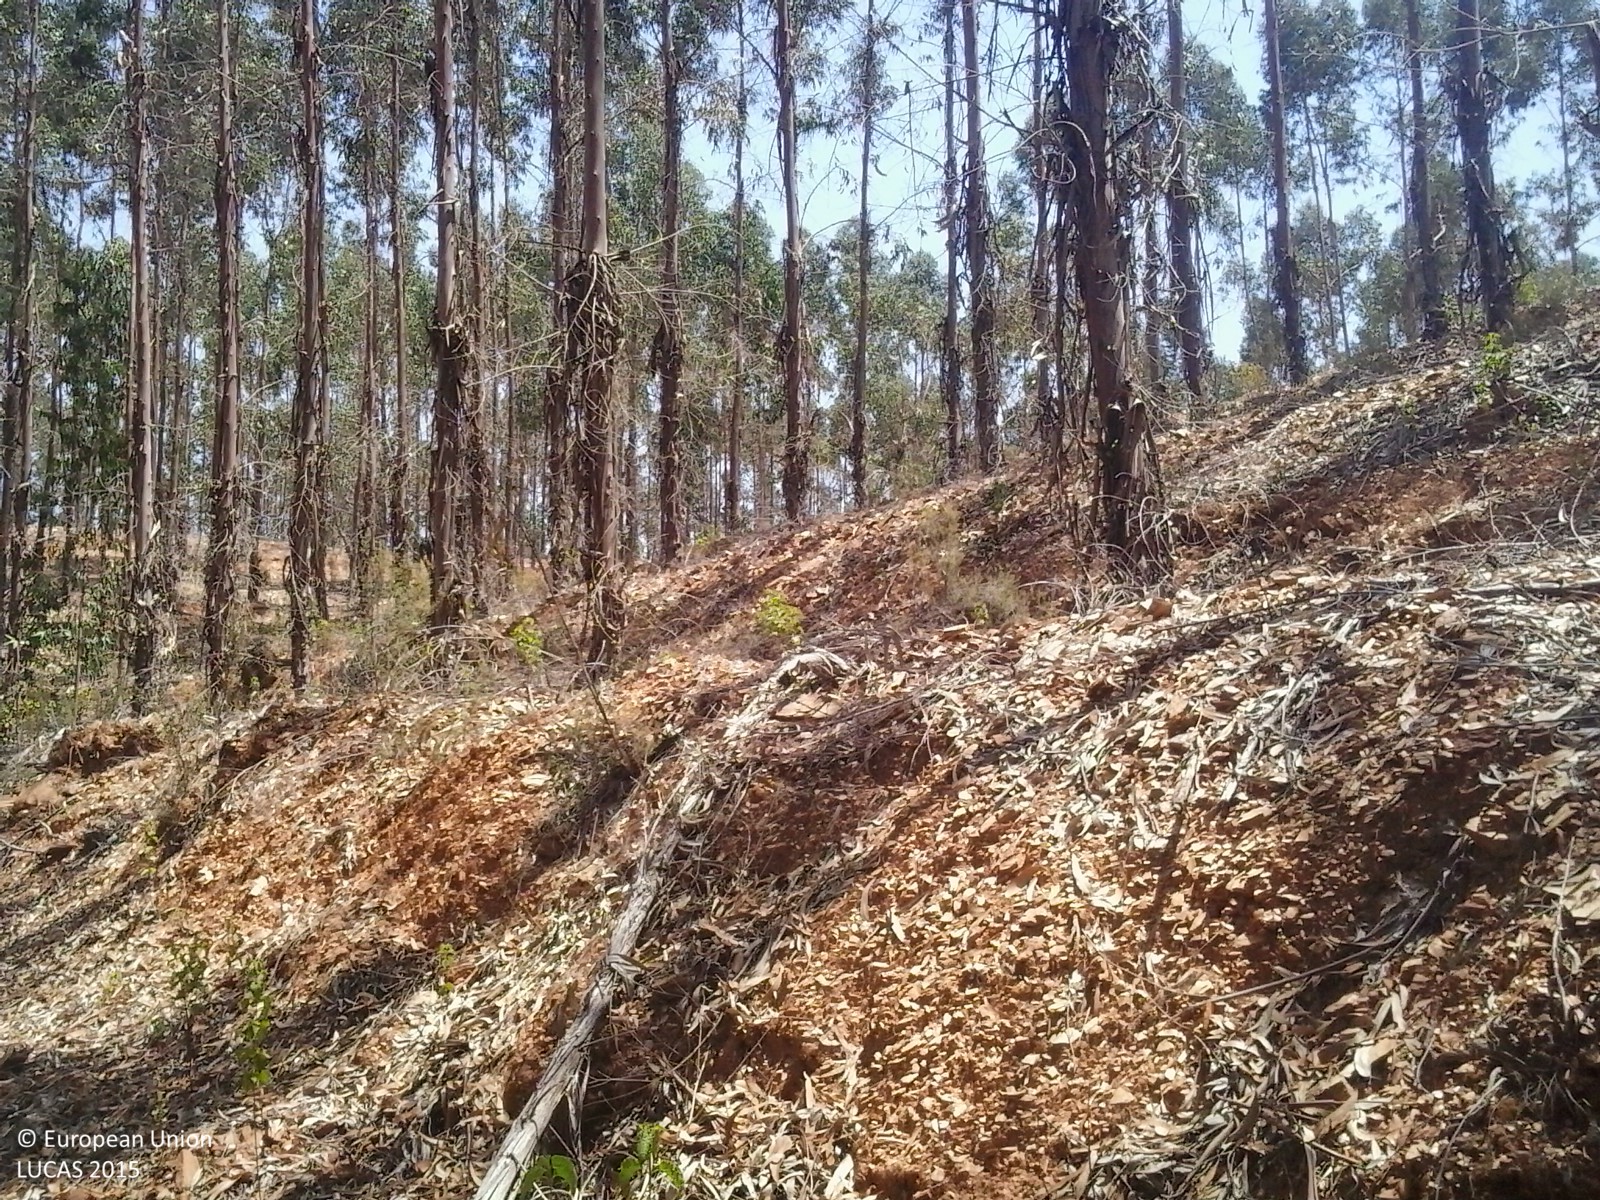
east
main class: Woodland
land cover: Broadleaved woodland
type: exotic forest
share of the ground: > 75 %
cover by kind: broadleaved forest trees 75 %, herbaceous plants 10 %, unconsolidated bare surface 10 %, shrubs 5 %
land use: Forestry
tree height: > 5 m
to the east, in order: Broadleaved woodland; Tracks; Broadleaved woodland; Tracks; Broadleaved woodland; Tracks; Broadleaved woodland; Tracks; Broadleaved woodland; Tracks; Broadleaved woodland
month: July
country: ES
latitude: 37.5435
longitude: -6.4342
